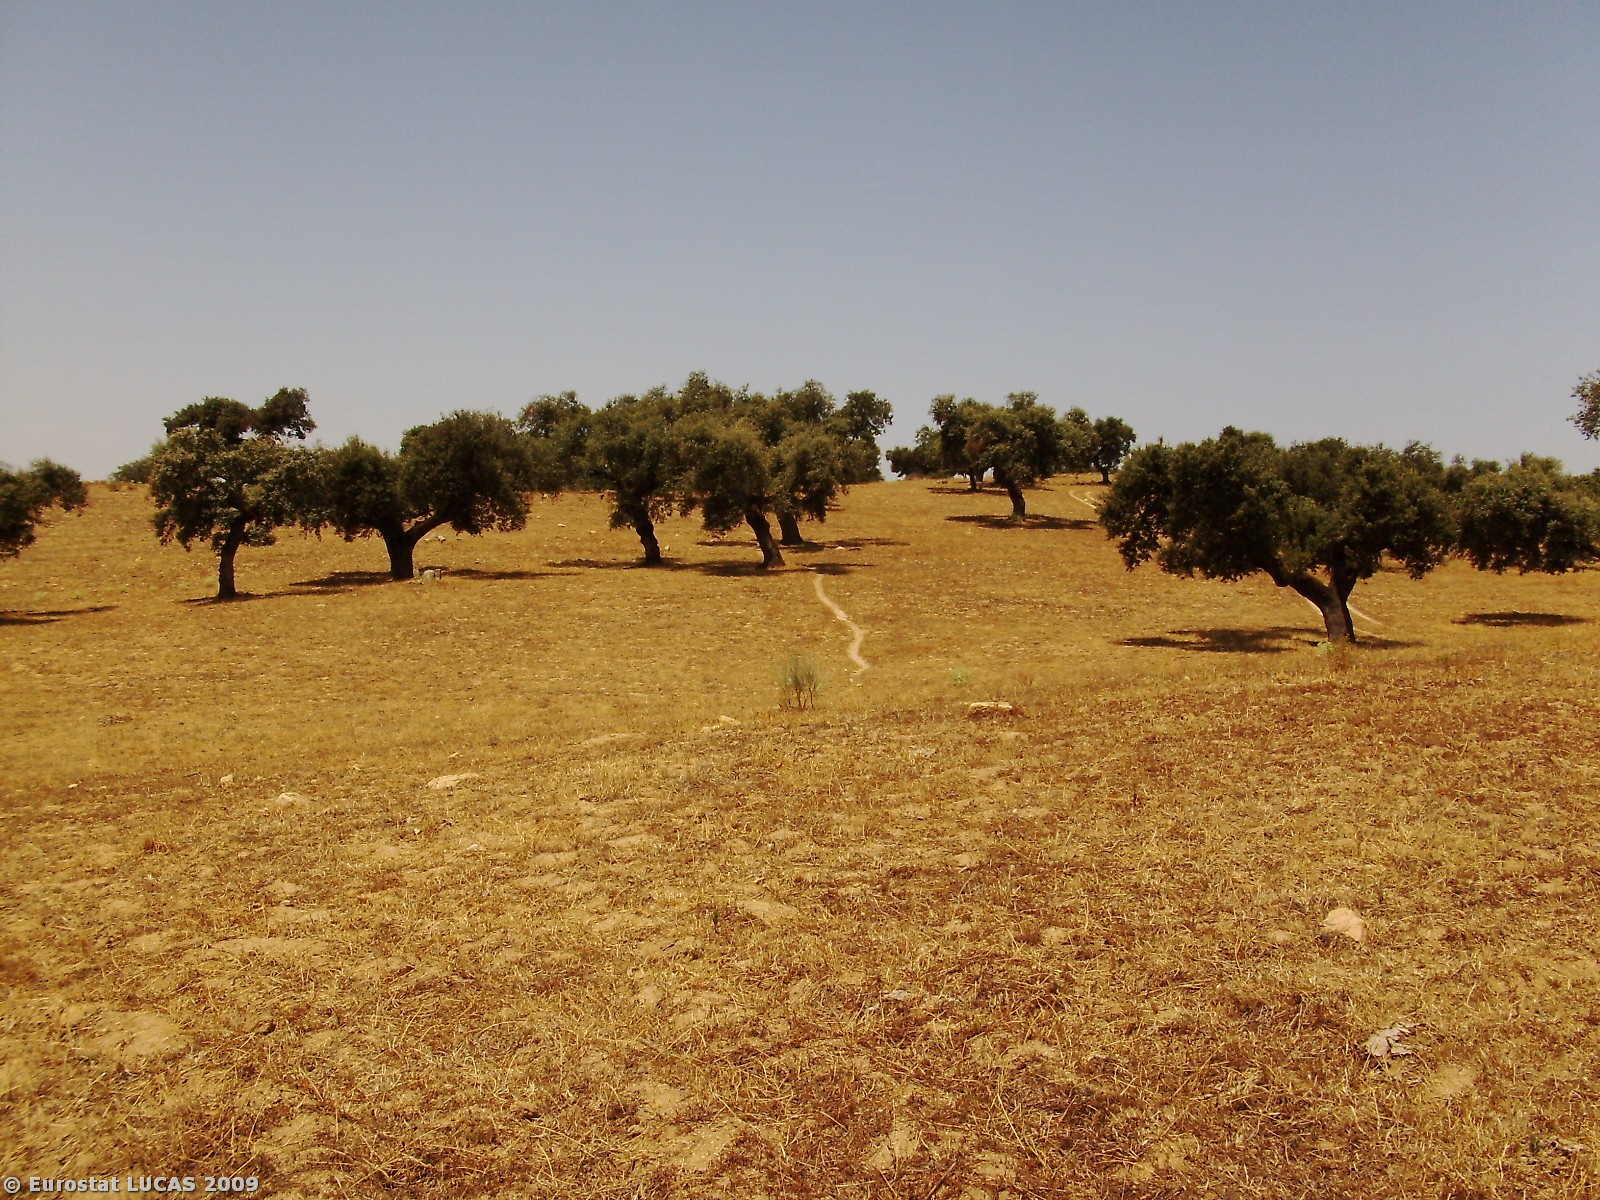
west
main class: Grassland
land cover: Grassland without tree/shrub cover
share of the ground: > 75 %
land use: Agriculture (excluding fallow land and kitchen gardens)
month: June
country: PT
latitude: 39.0873
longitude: -7.2951
